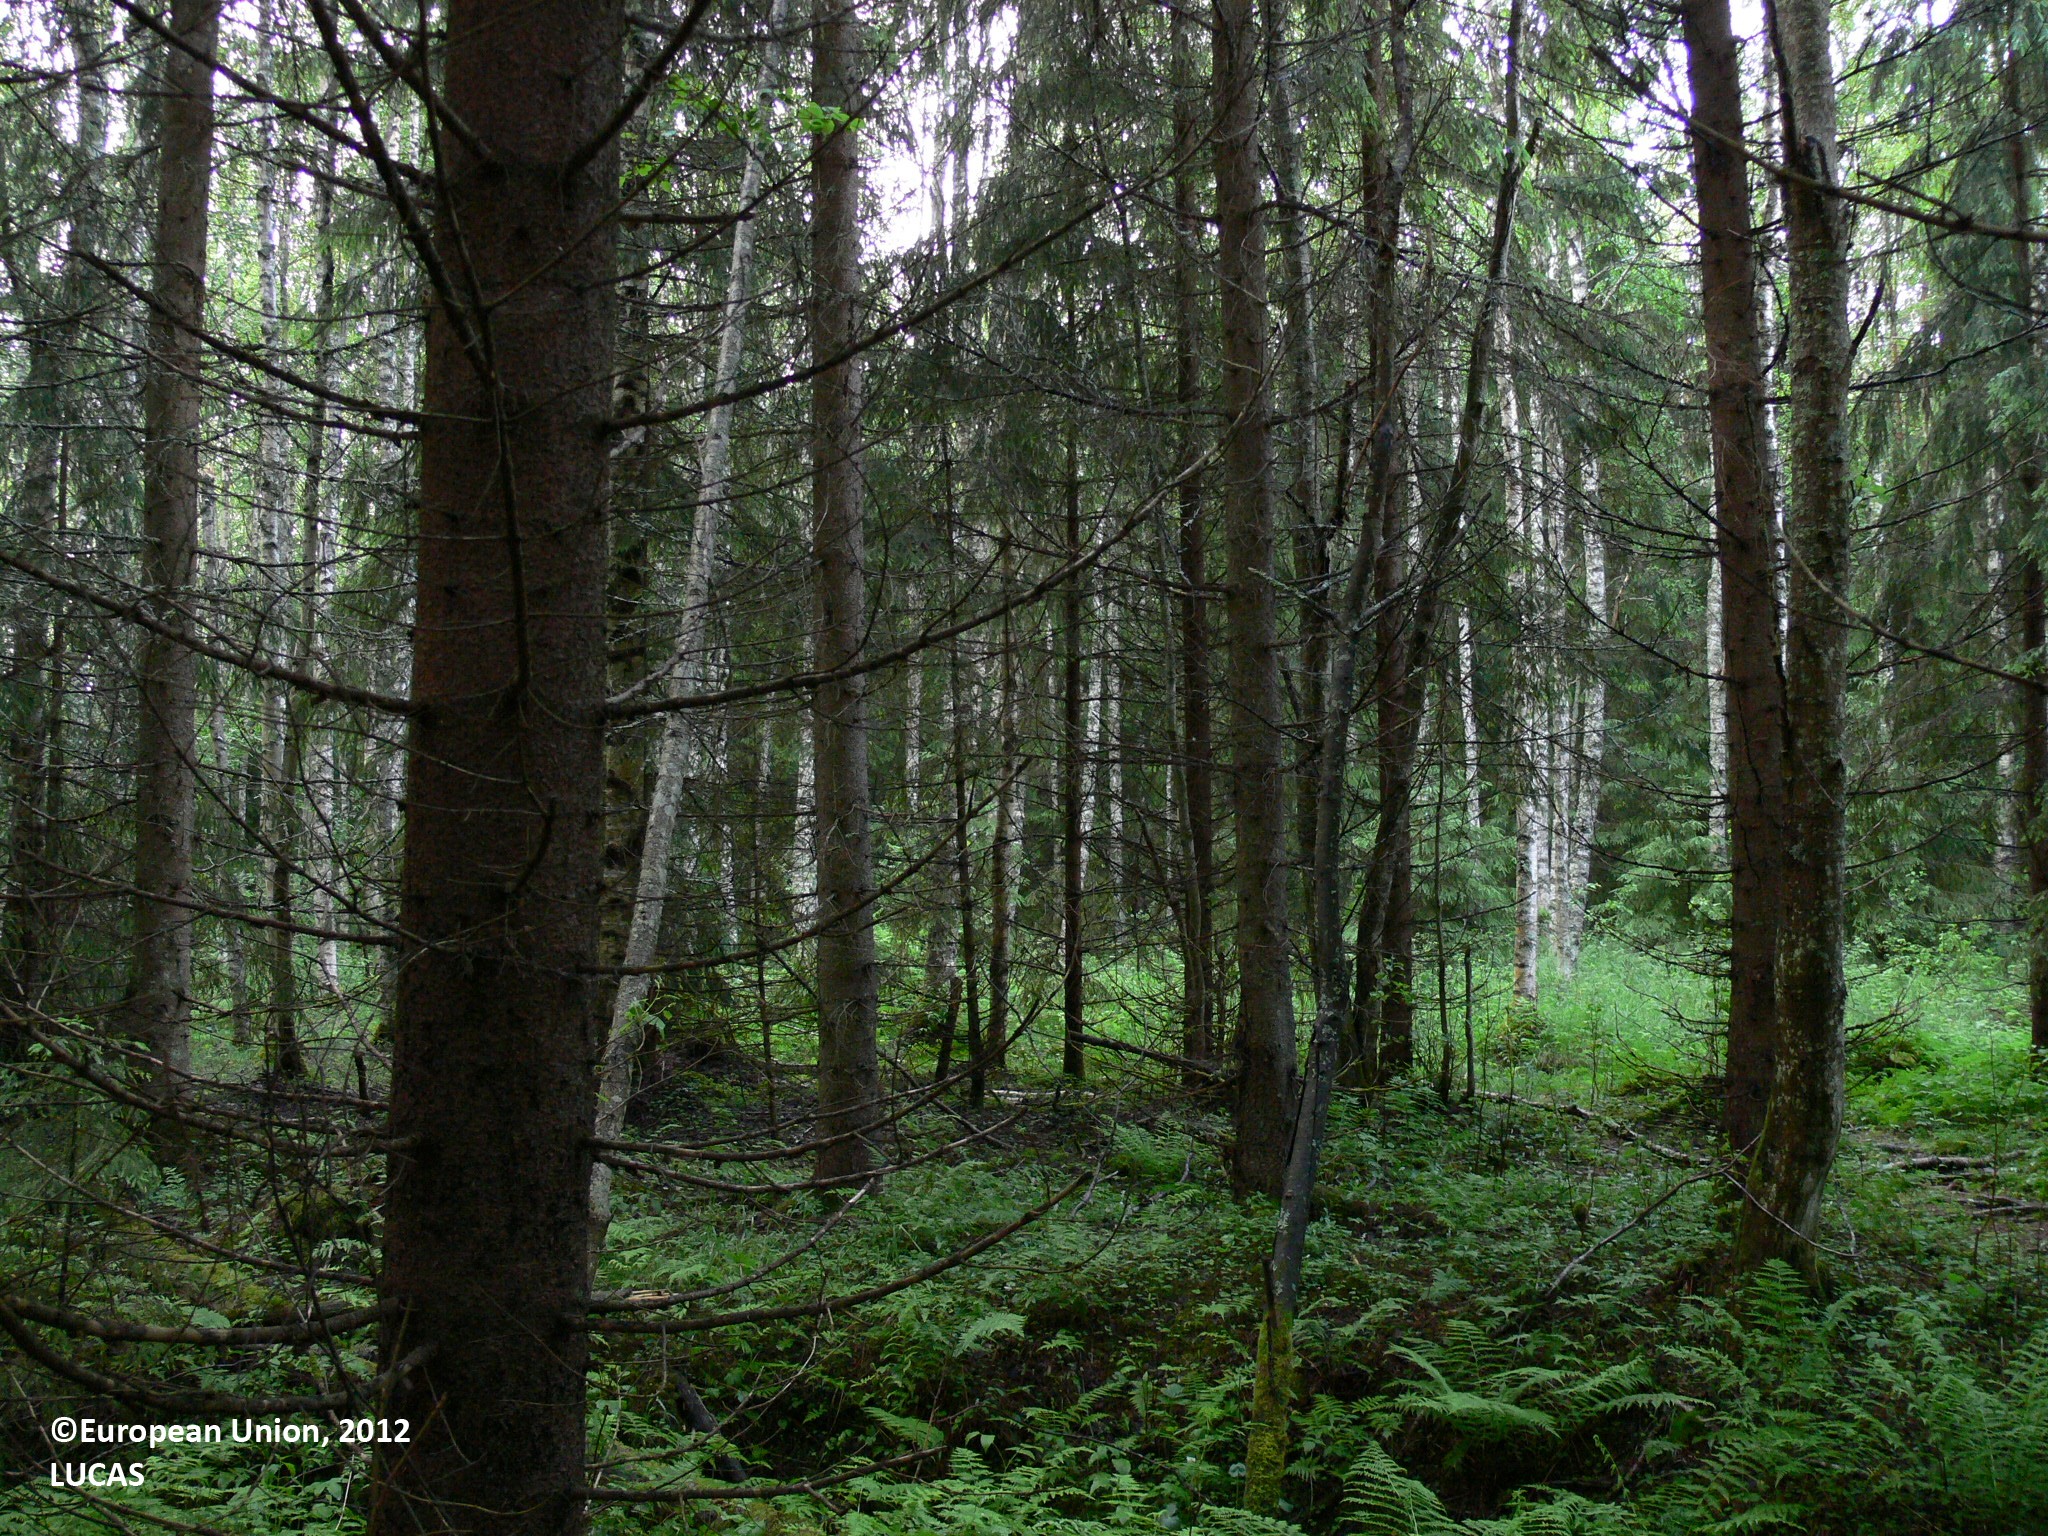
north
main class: Woodland
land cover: Spruce dominated mixed woodland
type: boreal forest
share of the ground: > 75 %
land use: Forestry
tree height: > 5 m
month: June
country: FI
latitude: 62.5584
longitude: 29.4339
